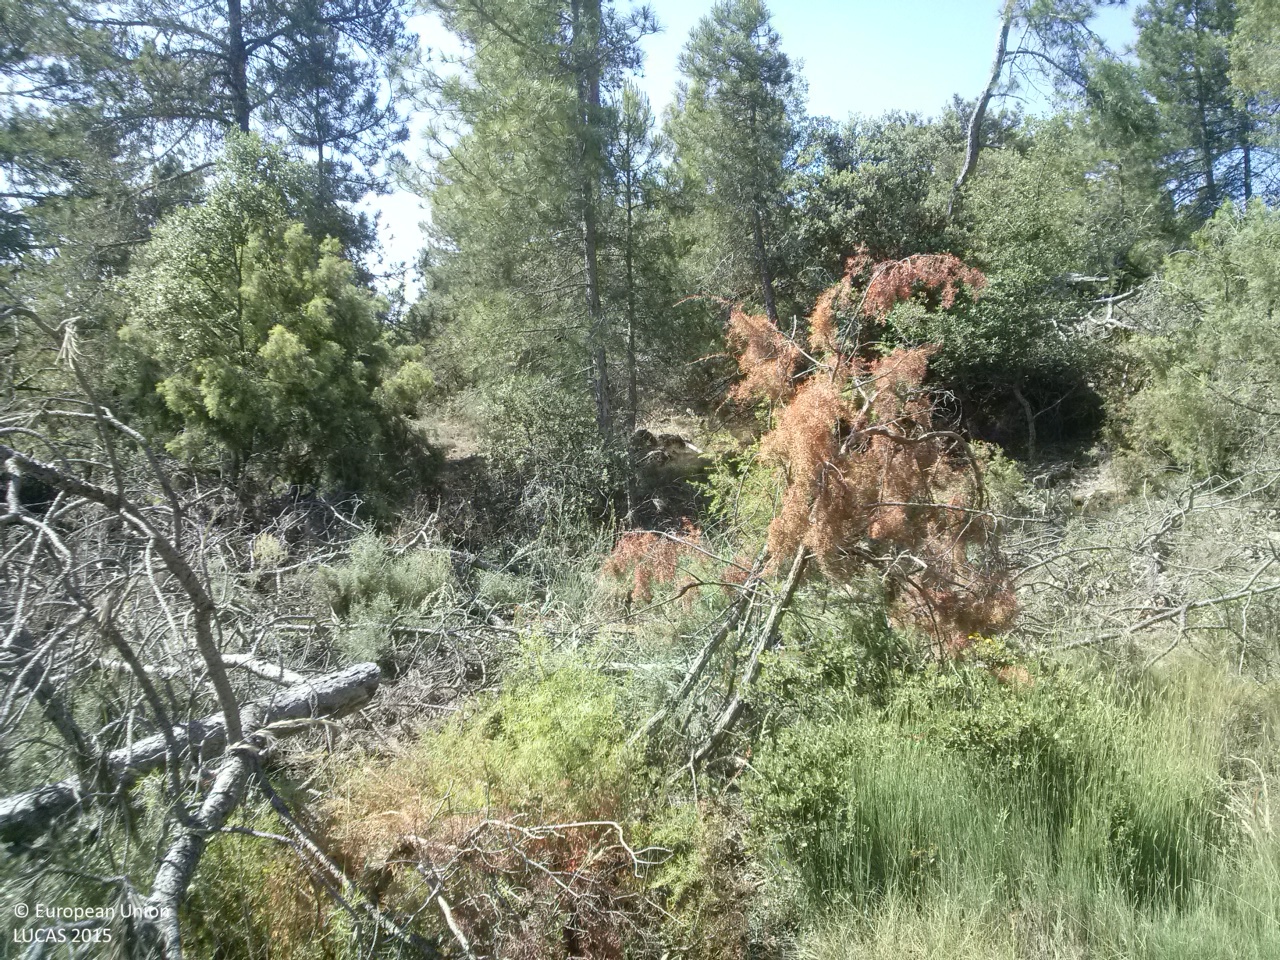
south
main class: Woodland
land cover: Pine dominated mixed woodland
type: coniferous forest of the mediterranean region
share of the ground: 10 - 25 %
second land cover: Shrubland without tree cover
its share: 25 - 50 %
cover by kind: shrubs 40 %, herbaceous plants 30 %, coniferous forest trees 20 %, broadleaved forest trees 10 %
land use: Forestry
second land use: Agriculture (excluding fallow land and kitchen gardens)
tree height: > 5 m
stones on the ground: 25 - 50 %
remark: Clear cut
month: June
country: ES
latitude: 39.9768
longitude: -1.6143
